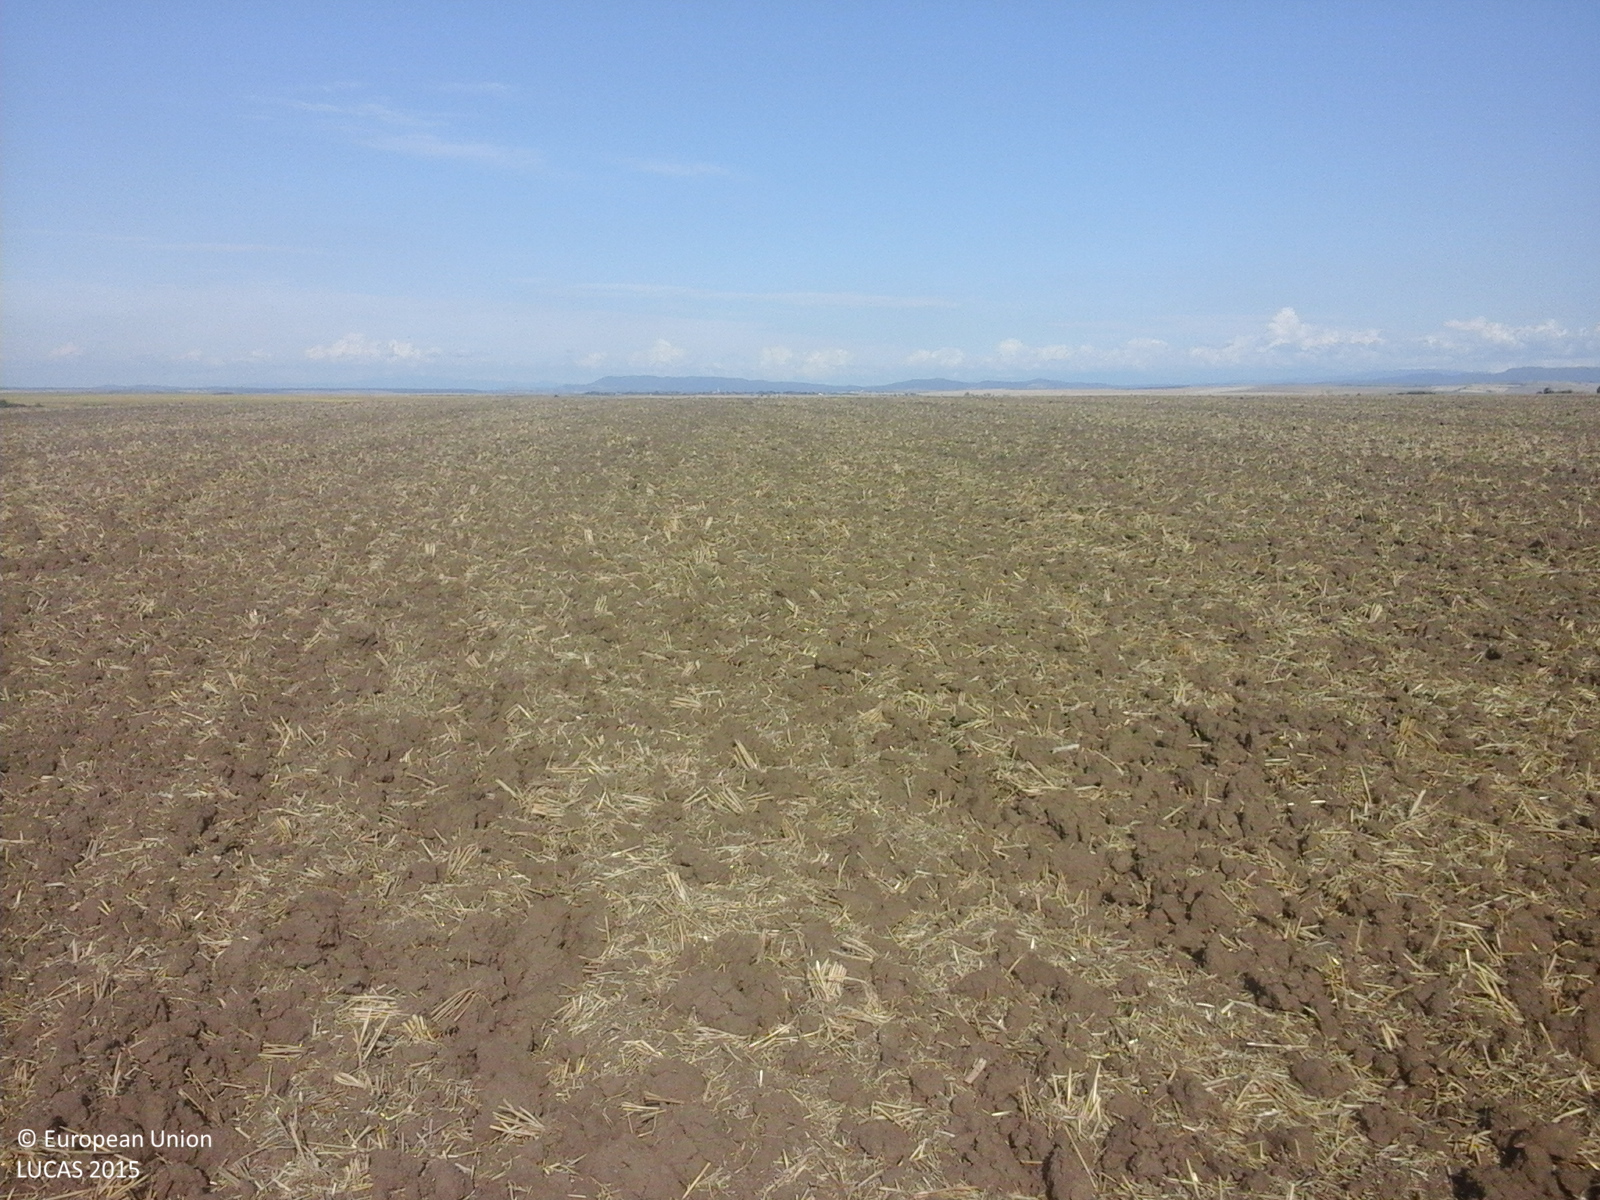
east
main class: Cropland
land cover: Common wheat
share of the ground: < 10 %
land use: Agriculture (excluding fallow land and kitchen gardens)
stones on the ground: < 10 %
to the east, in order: Common wheat
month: August
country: RO
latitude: 45.3928
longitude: 21.4117
